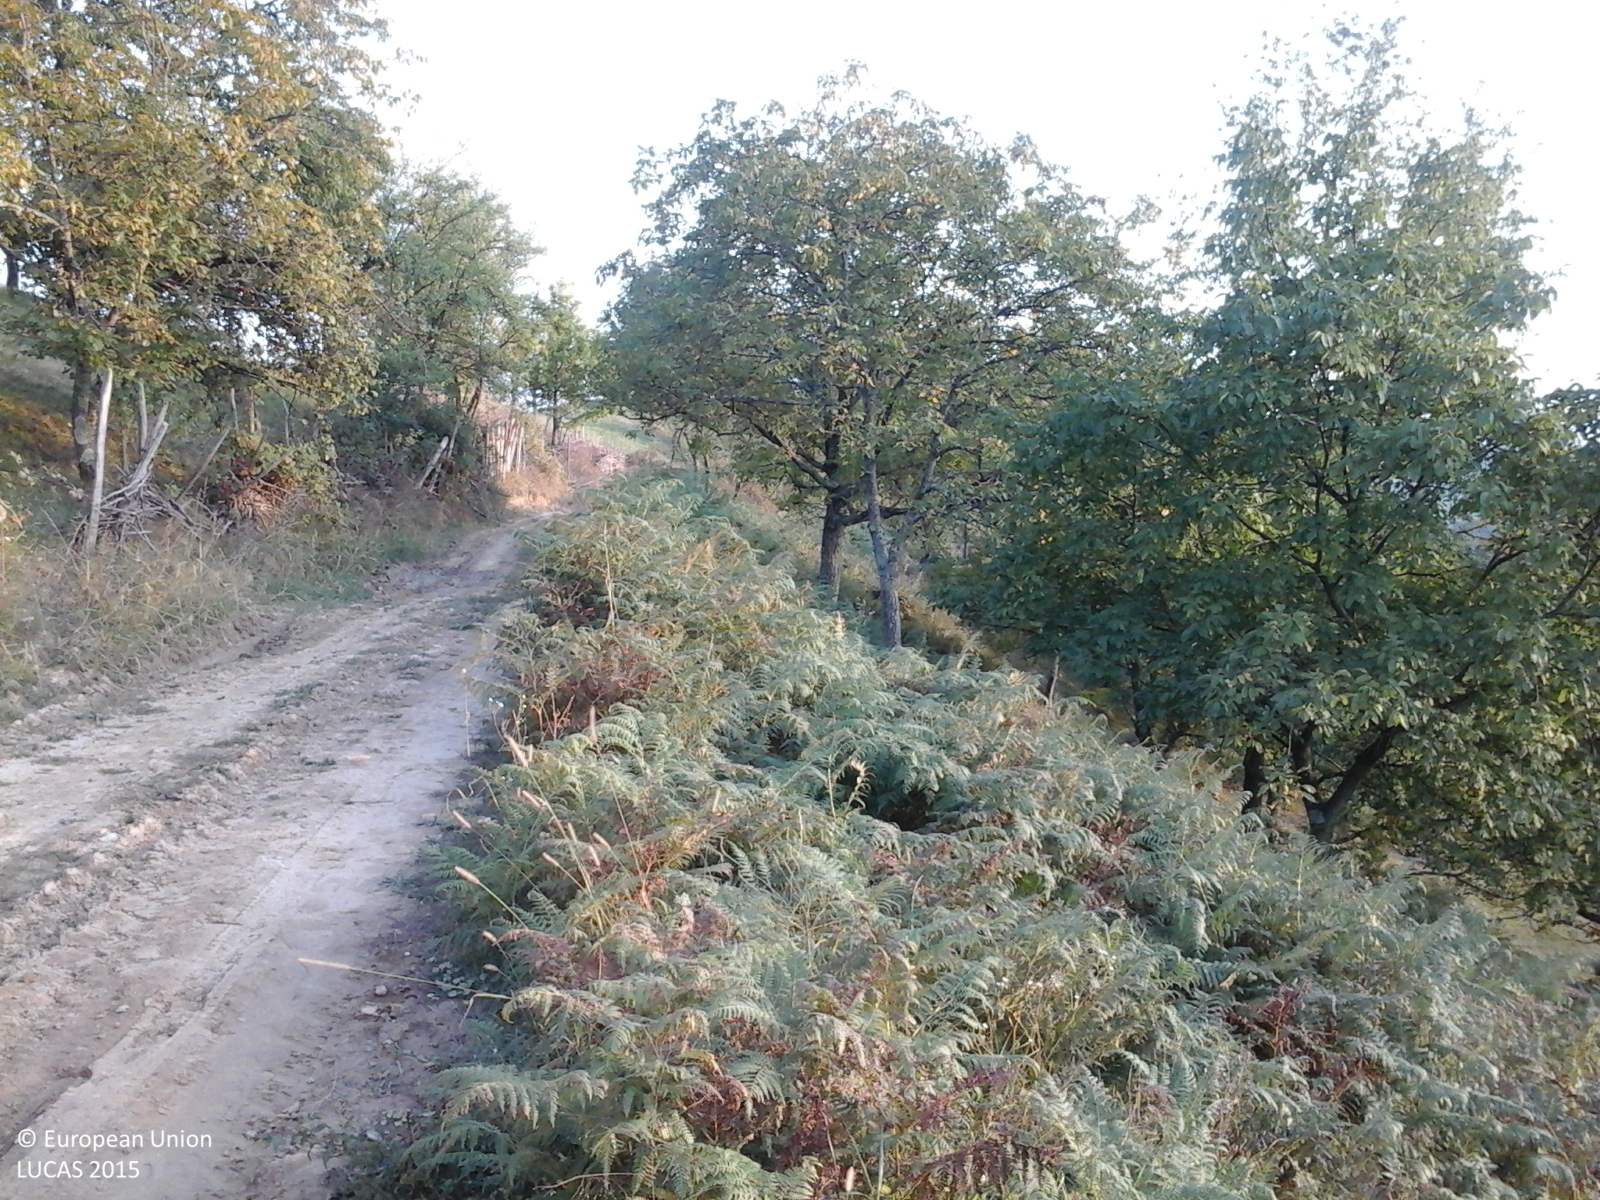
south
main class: Grassland
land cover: Grassland with sparse tree/shrub cover
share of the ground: > 75 %
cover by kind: herbaceous plants 85 %, shrubs 10 %, broadleaved forest trees 5 %
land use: Agriculture (excluding fallow land and kitchen gardens)
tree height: > 5 m
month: September
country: RO
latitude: 46.7530
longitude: 22.4228
